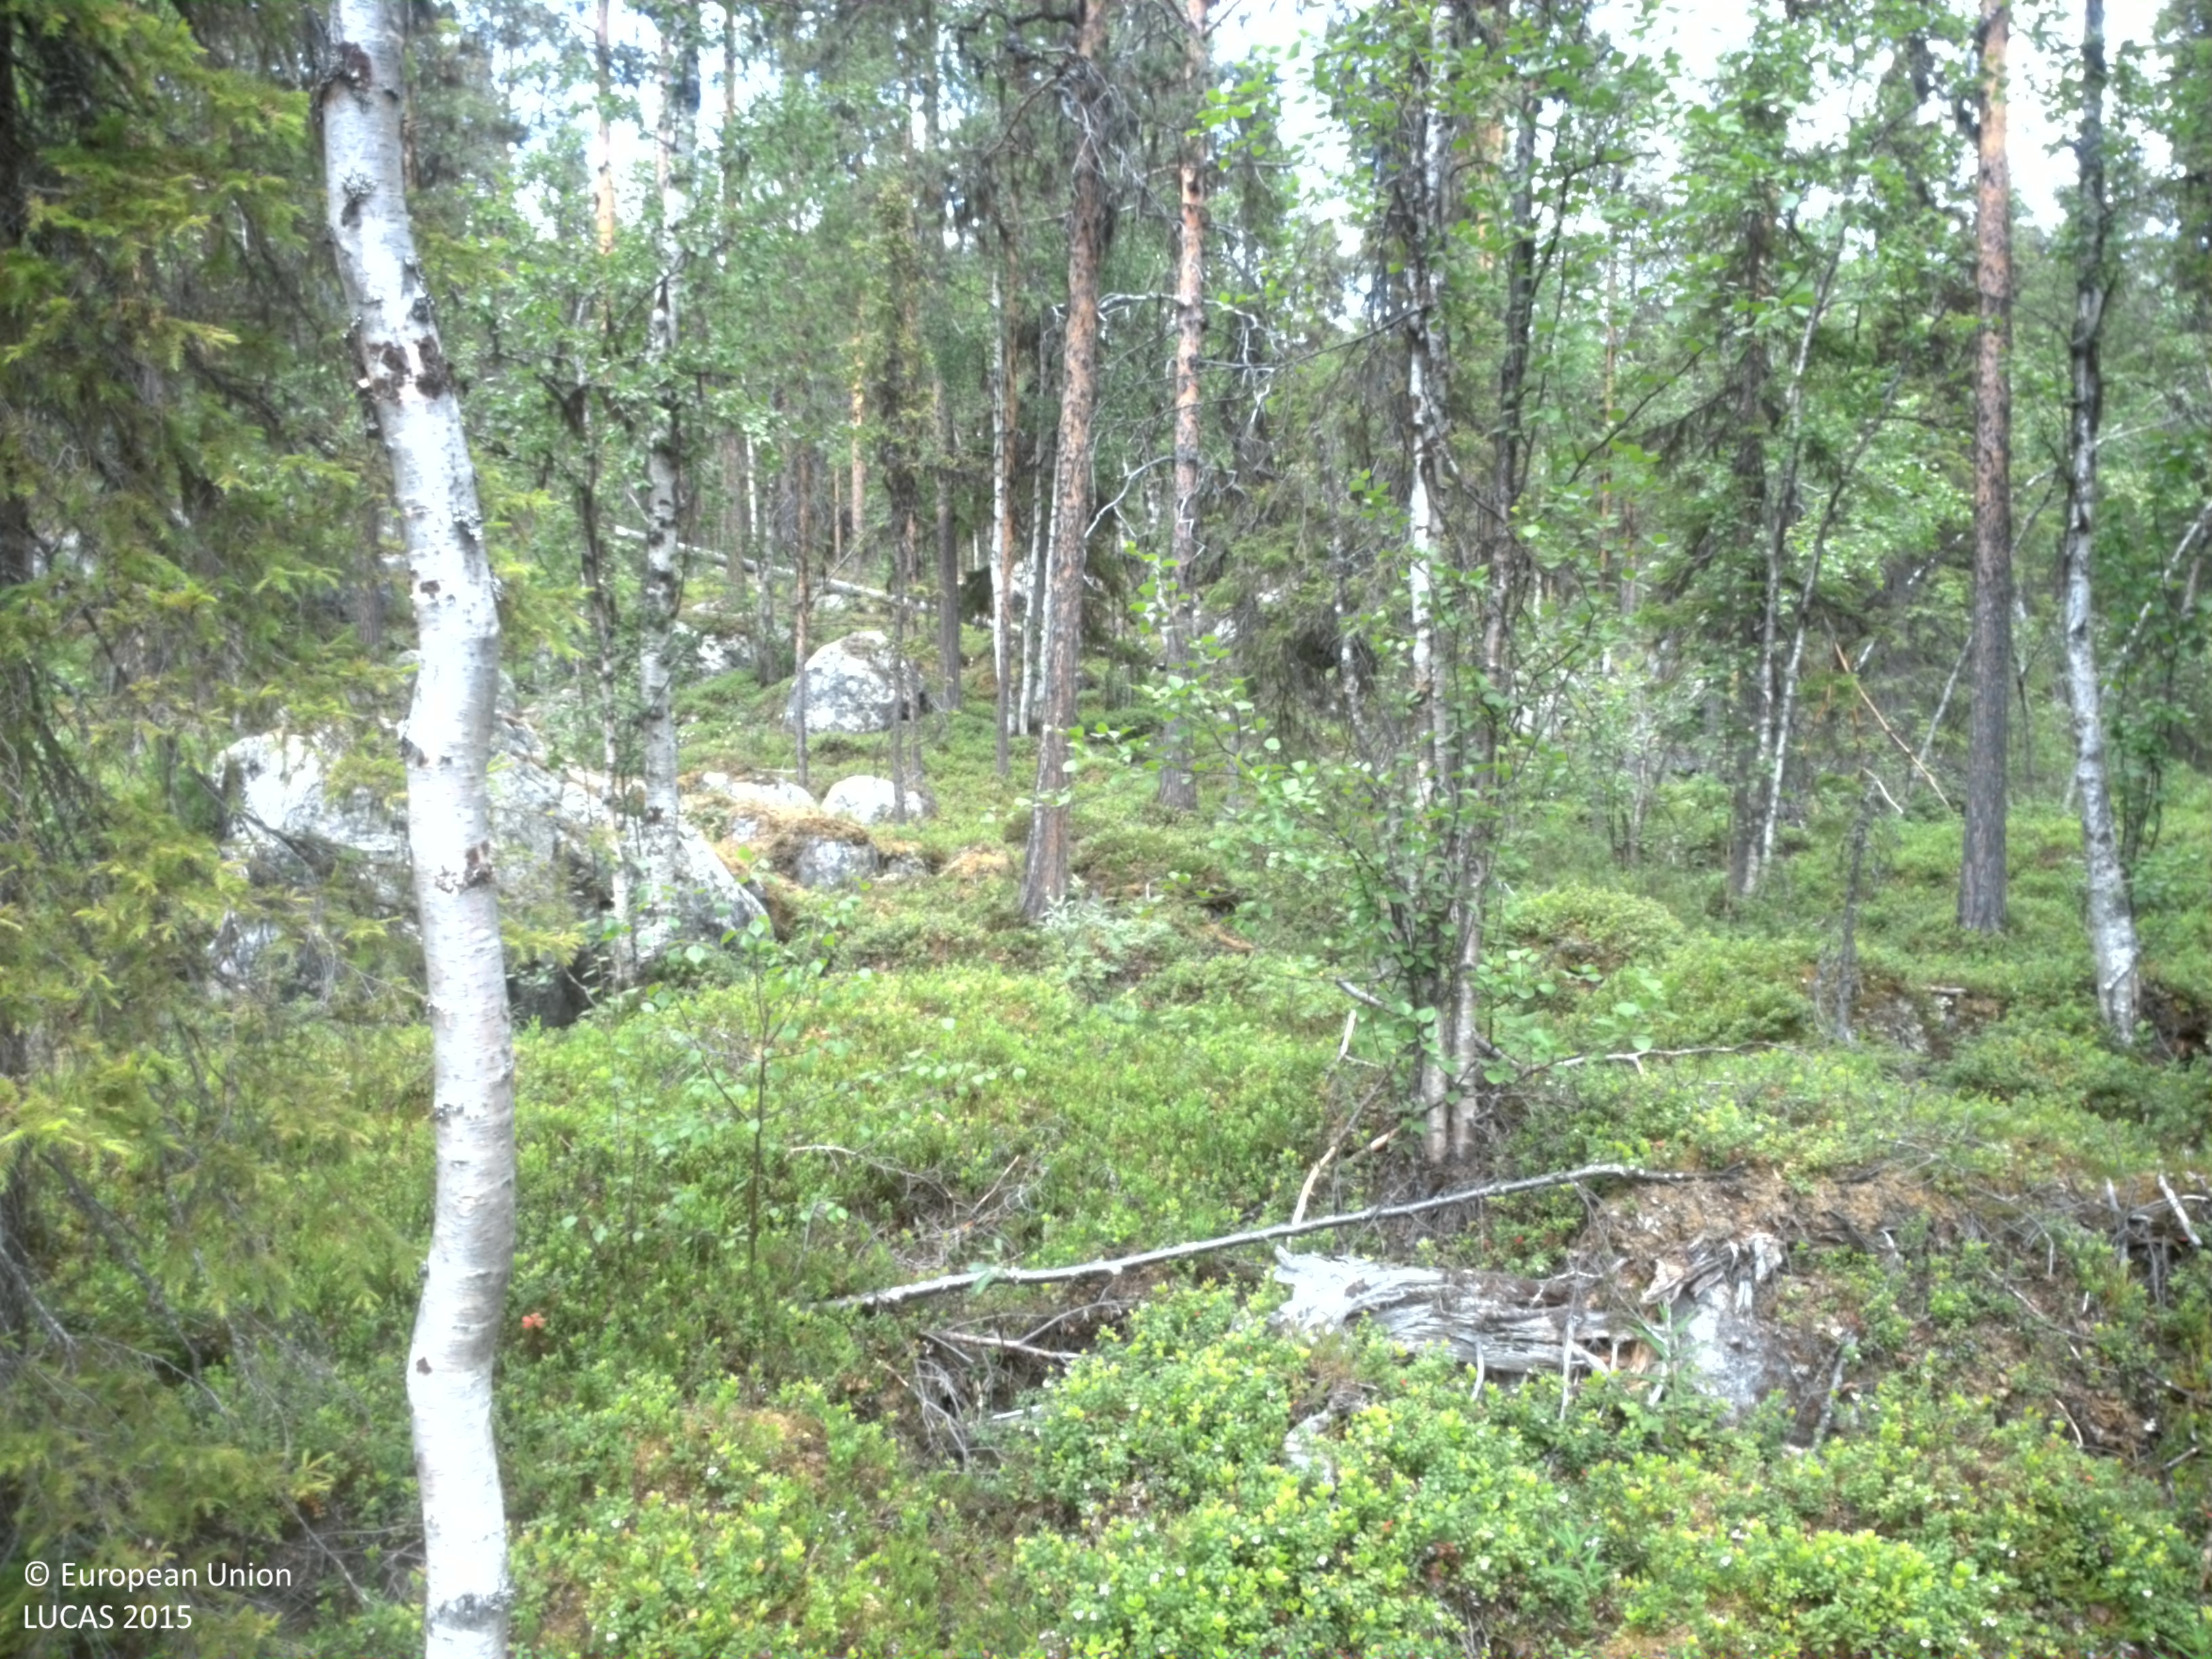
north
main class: Woodland
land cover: Pine dominated coniferous woodland
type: boreal forest
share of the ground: 25 - 50 %
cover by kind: shrubs 50 %, coniferous forest trees 35 %, consolidated bare surface 10 %, broadleaved forest trees 5 %
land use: Forestry
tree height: > 5 m
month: July
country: SE
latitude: 66.8929
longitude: 18.2819
